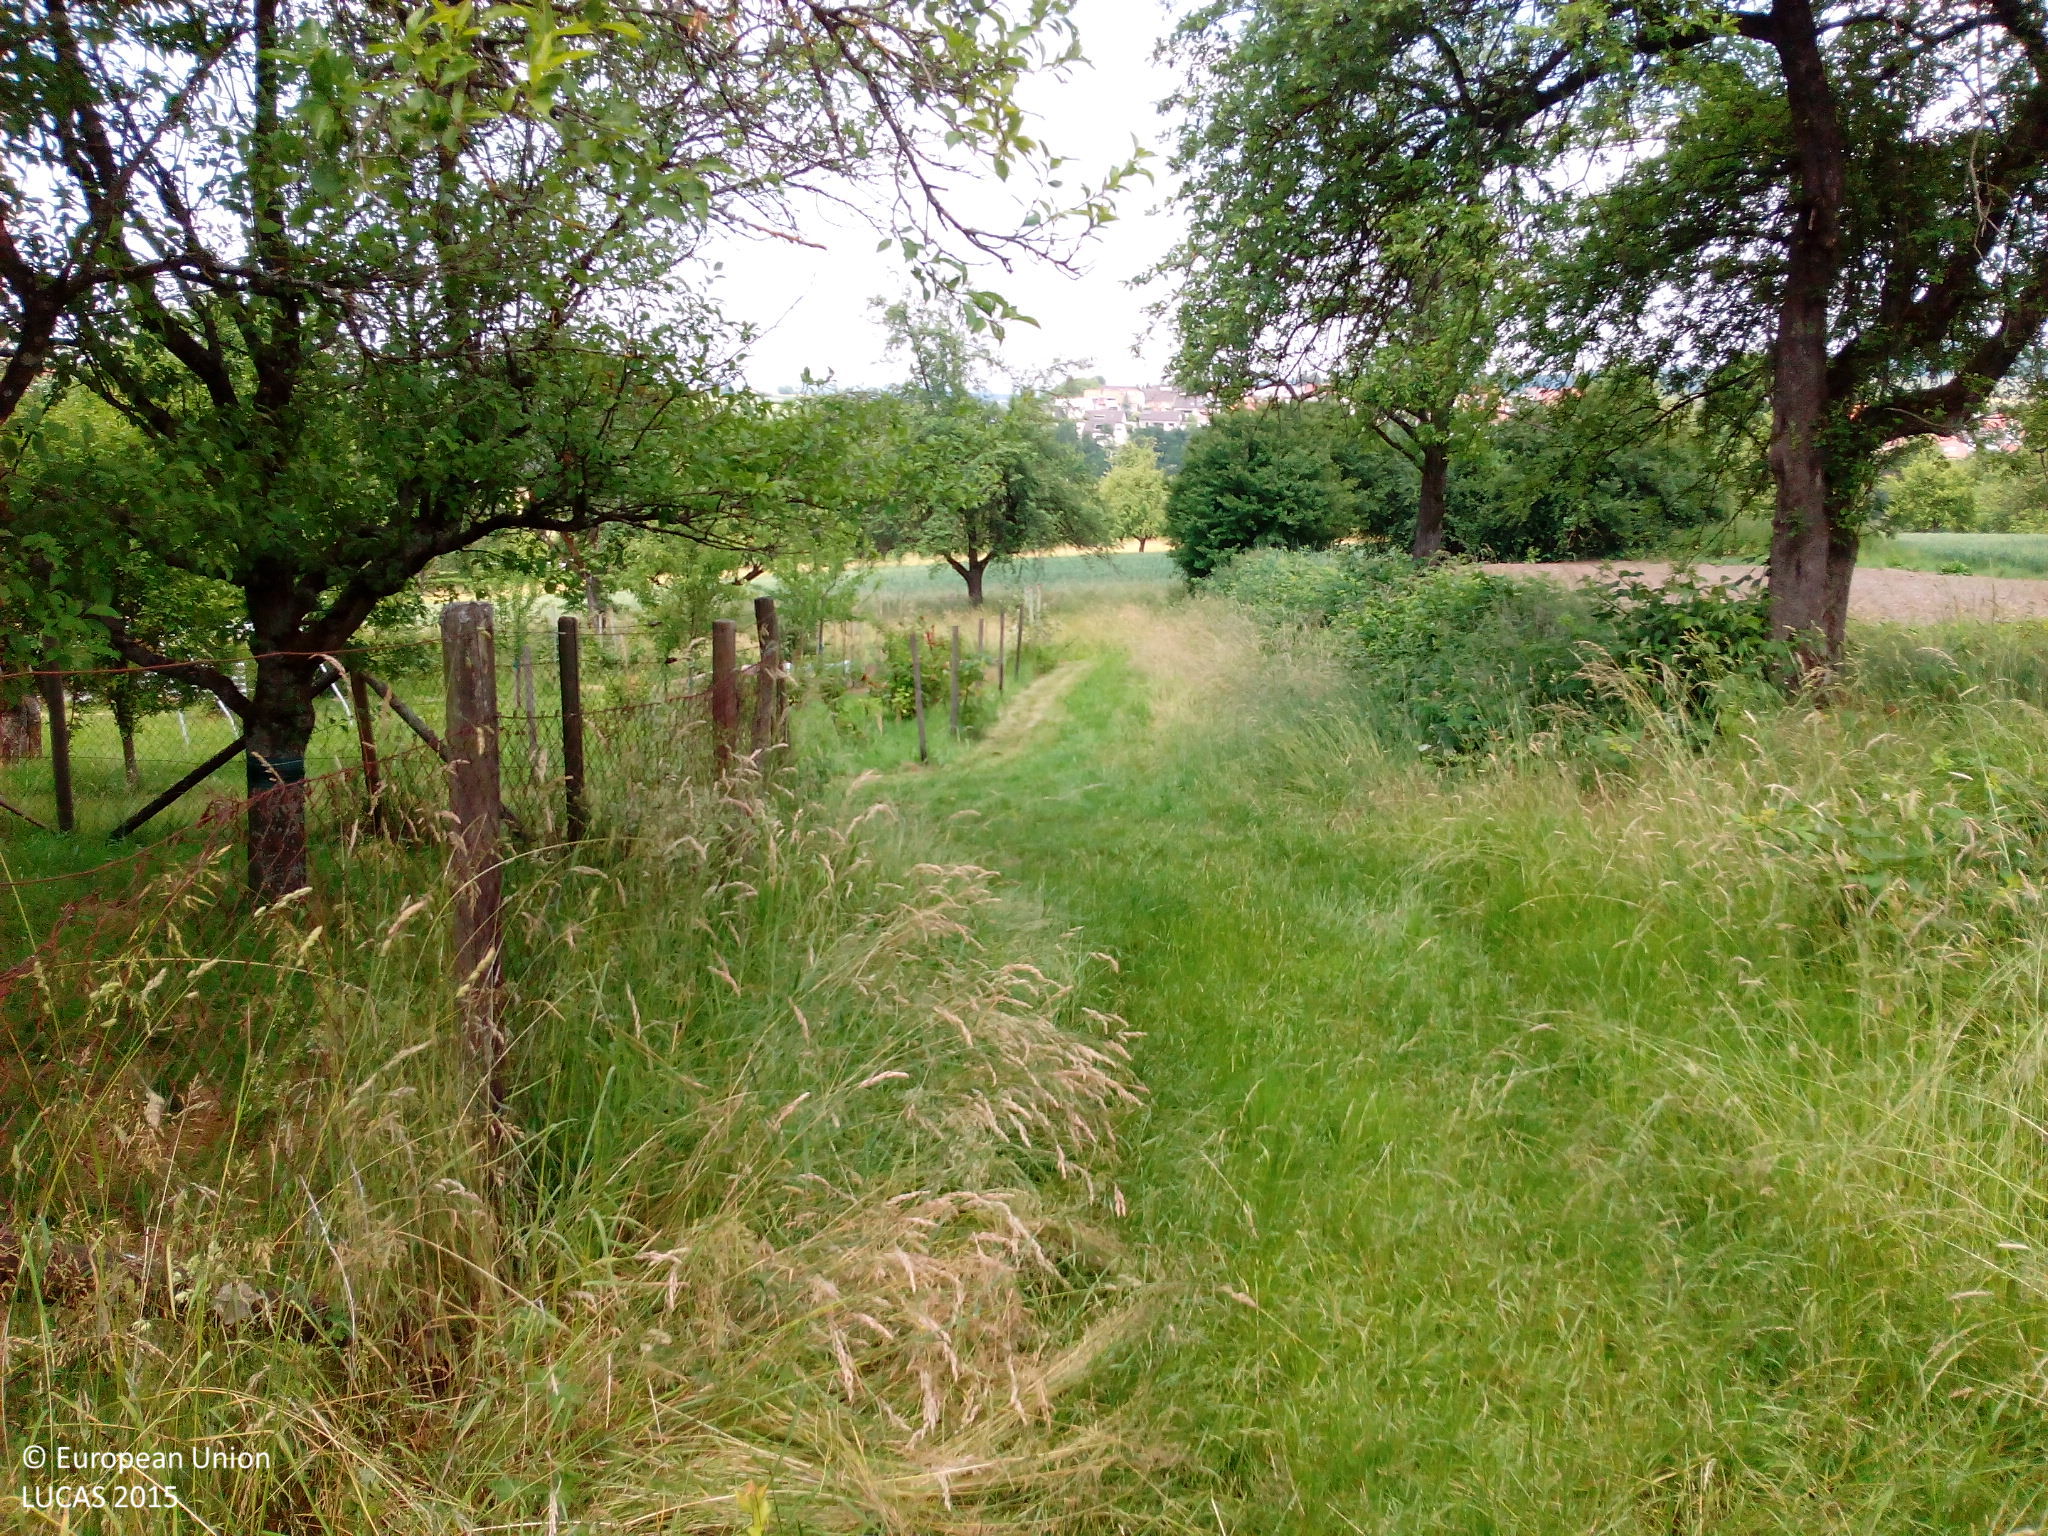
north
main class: Cropland
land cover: Apple fruit
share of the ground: 50 - 75 %
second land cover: Grassland without tree/shrub cover
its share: 50 - 75 %
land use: Agriculture (excluding fallow land and kitchen gardens)
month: June
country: DE
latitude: 48.8697
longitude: 9.4140
